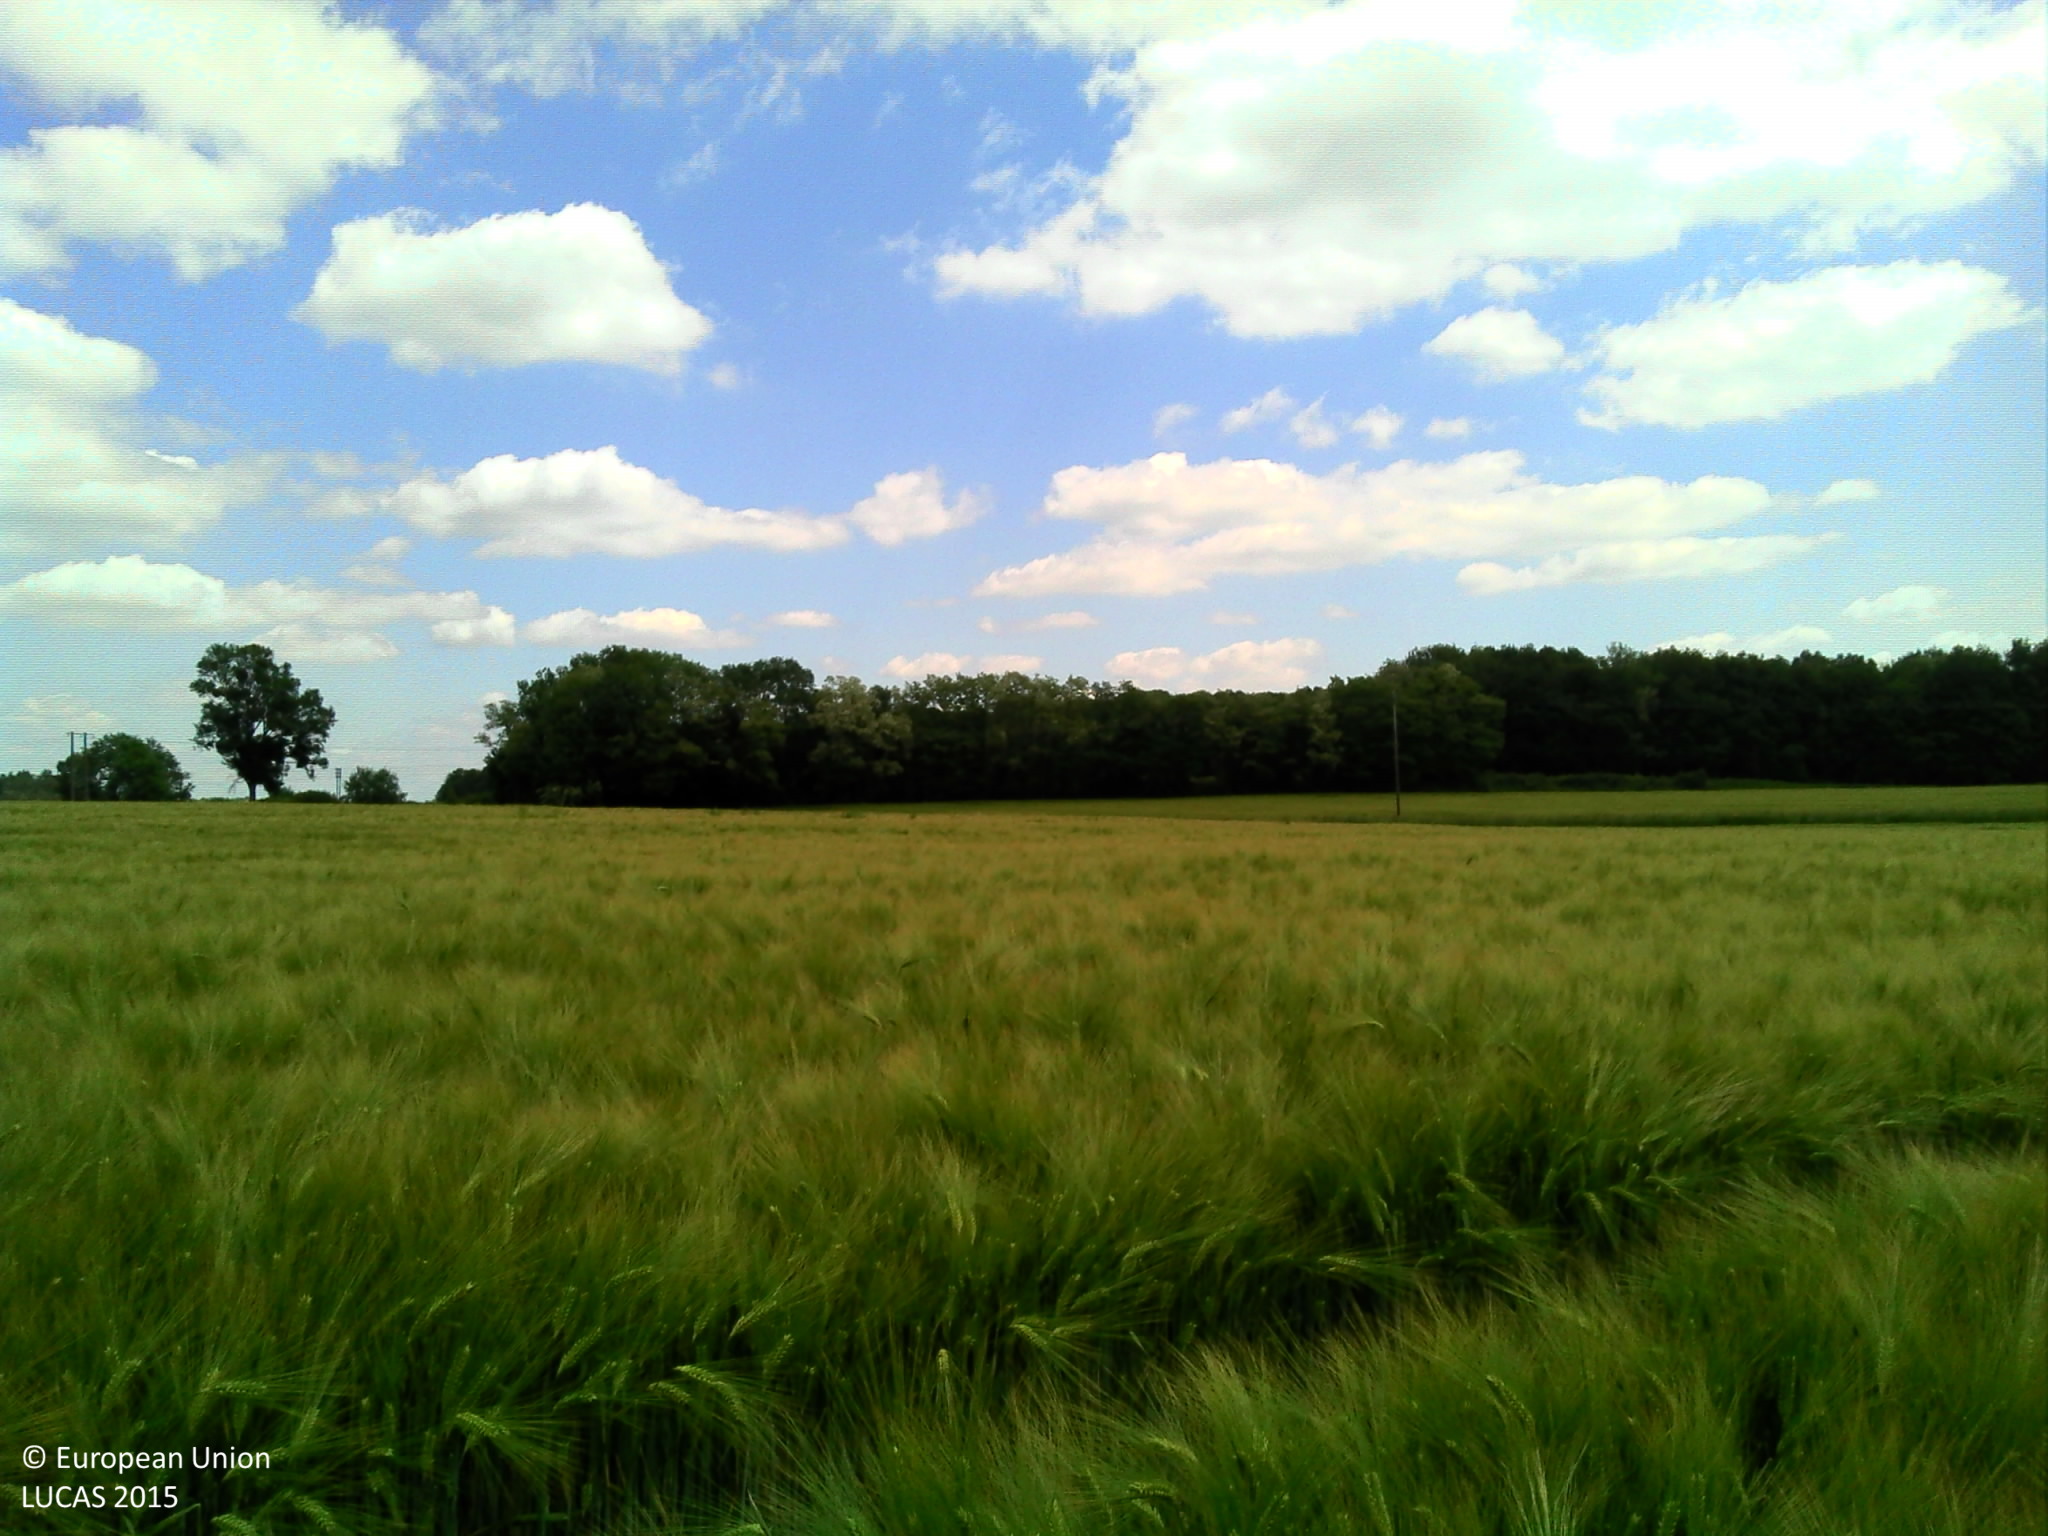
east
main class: Cropland
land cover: Common wheat
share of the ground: > 75 %
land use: Agriculture (excluding fallow land and kitchen gardens)
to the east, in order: Common wheat; Grass margins; Paved roads, cycling and walking lanes
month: May
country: FR
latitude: 47.7201
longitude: 6.0418
